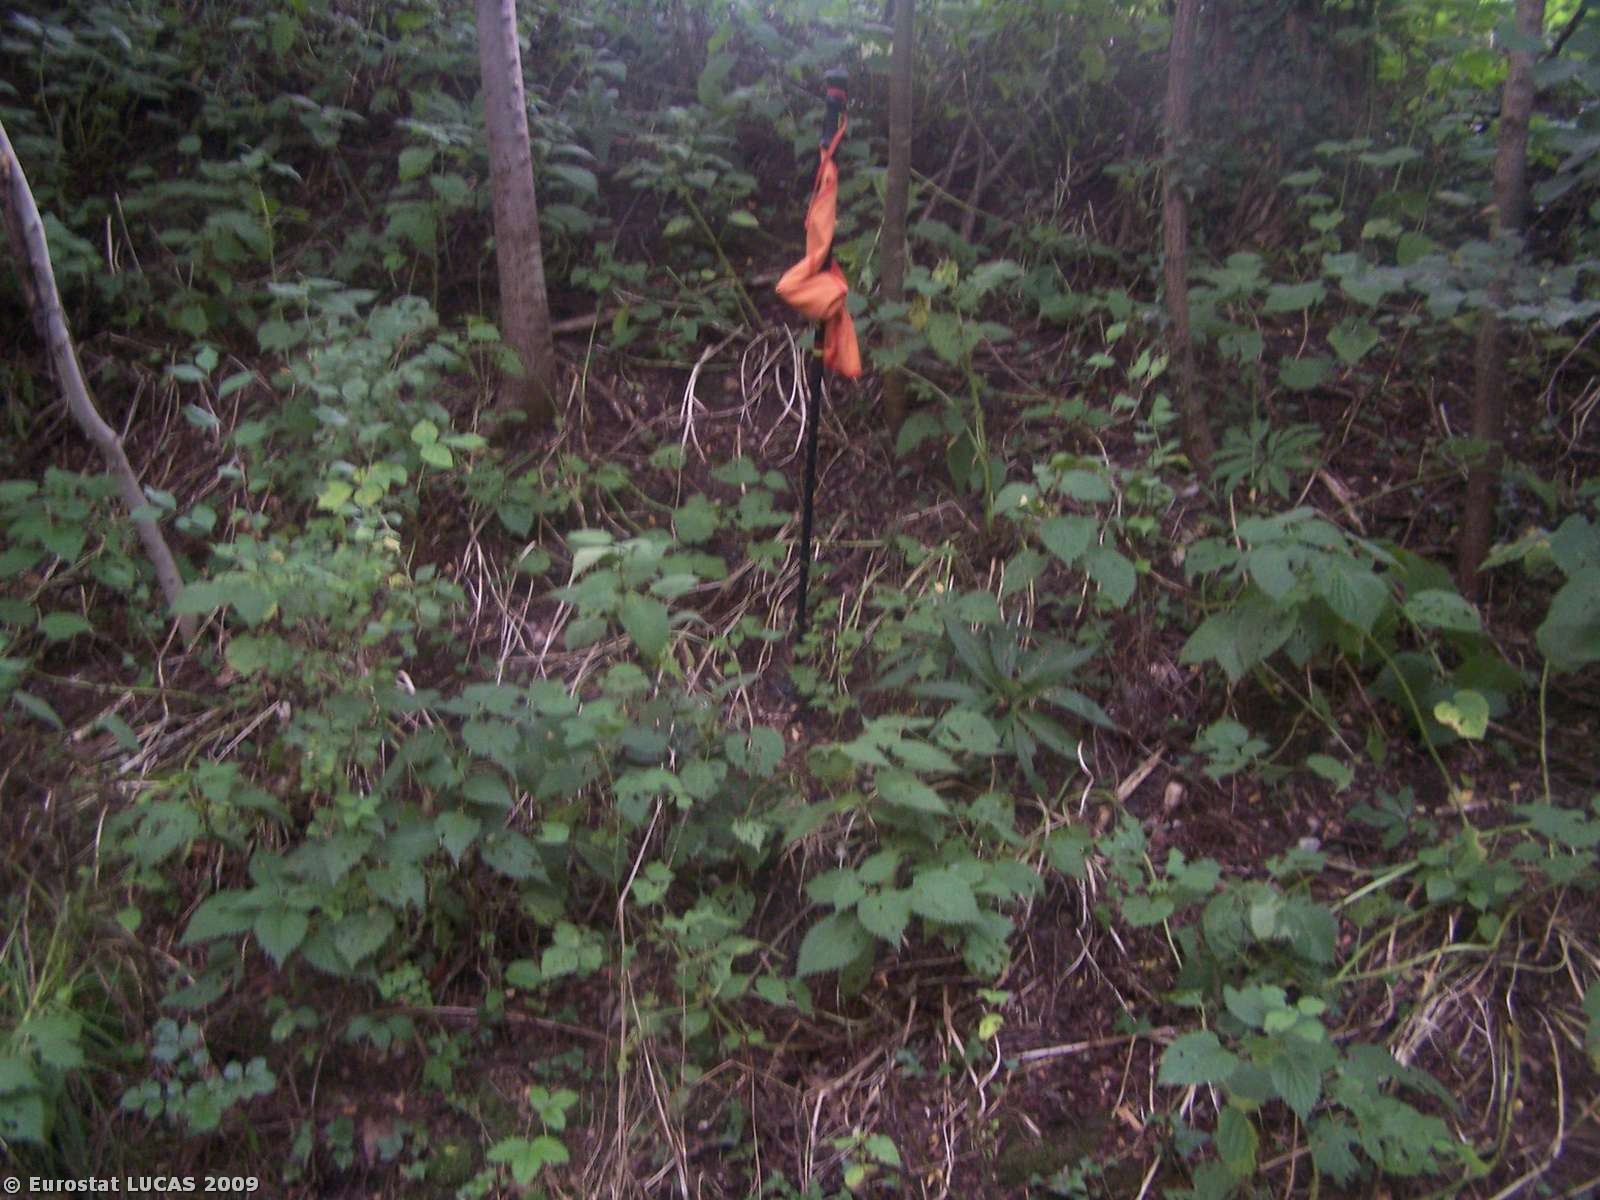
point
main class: Woodland
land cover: Broadleaved woodland
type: mesophytic deciduous forest
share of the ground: > 75 %
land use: Forestry
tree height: > 5 m
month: July
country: IT
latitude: 46.1833
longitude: 12.9893
